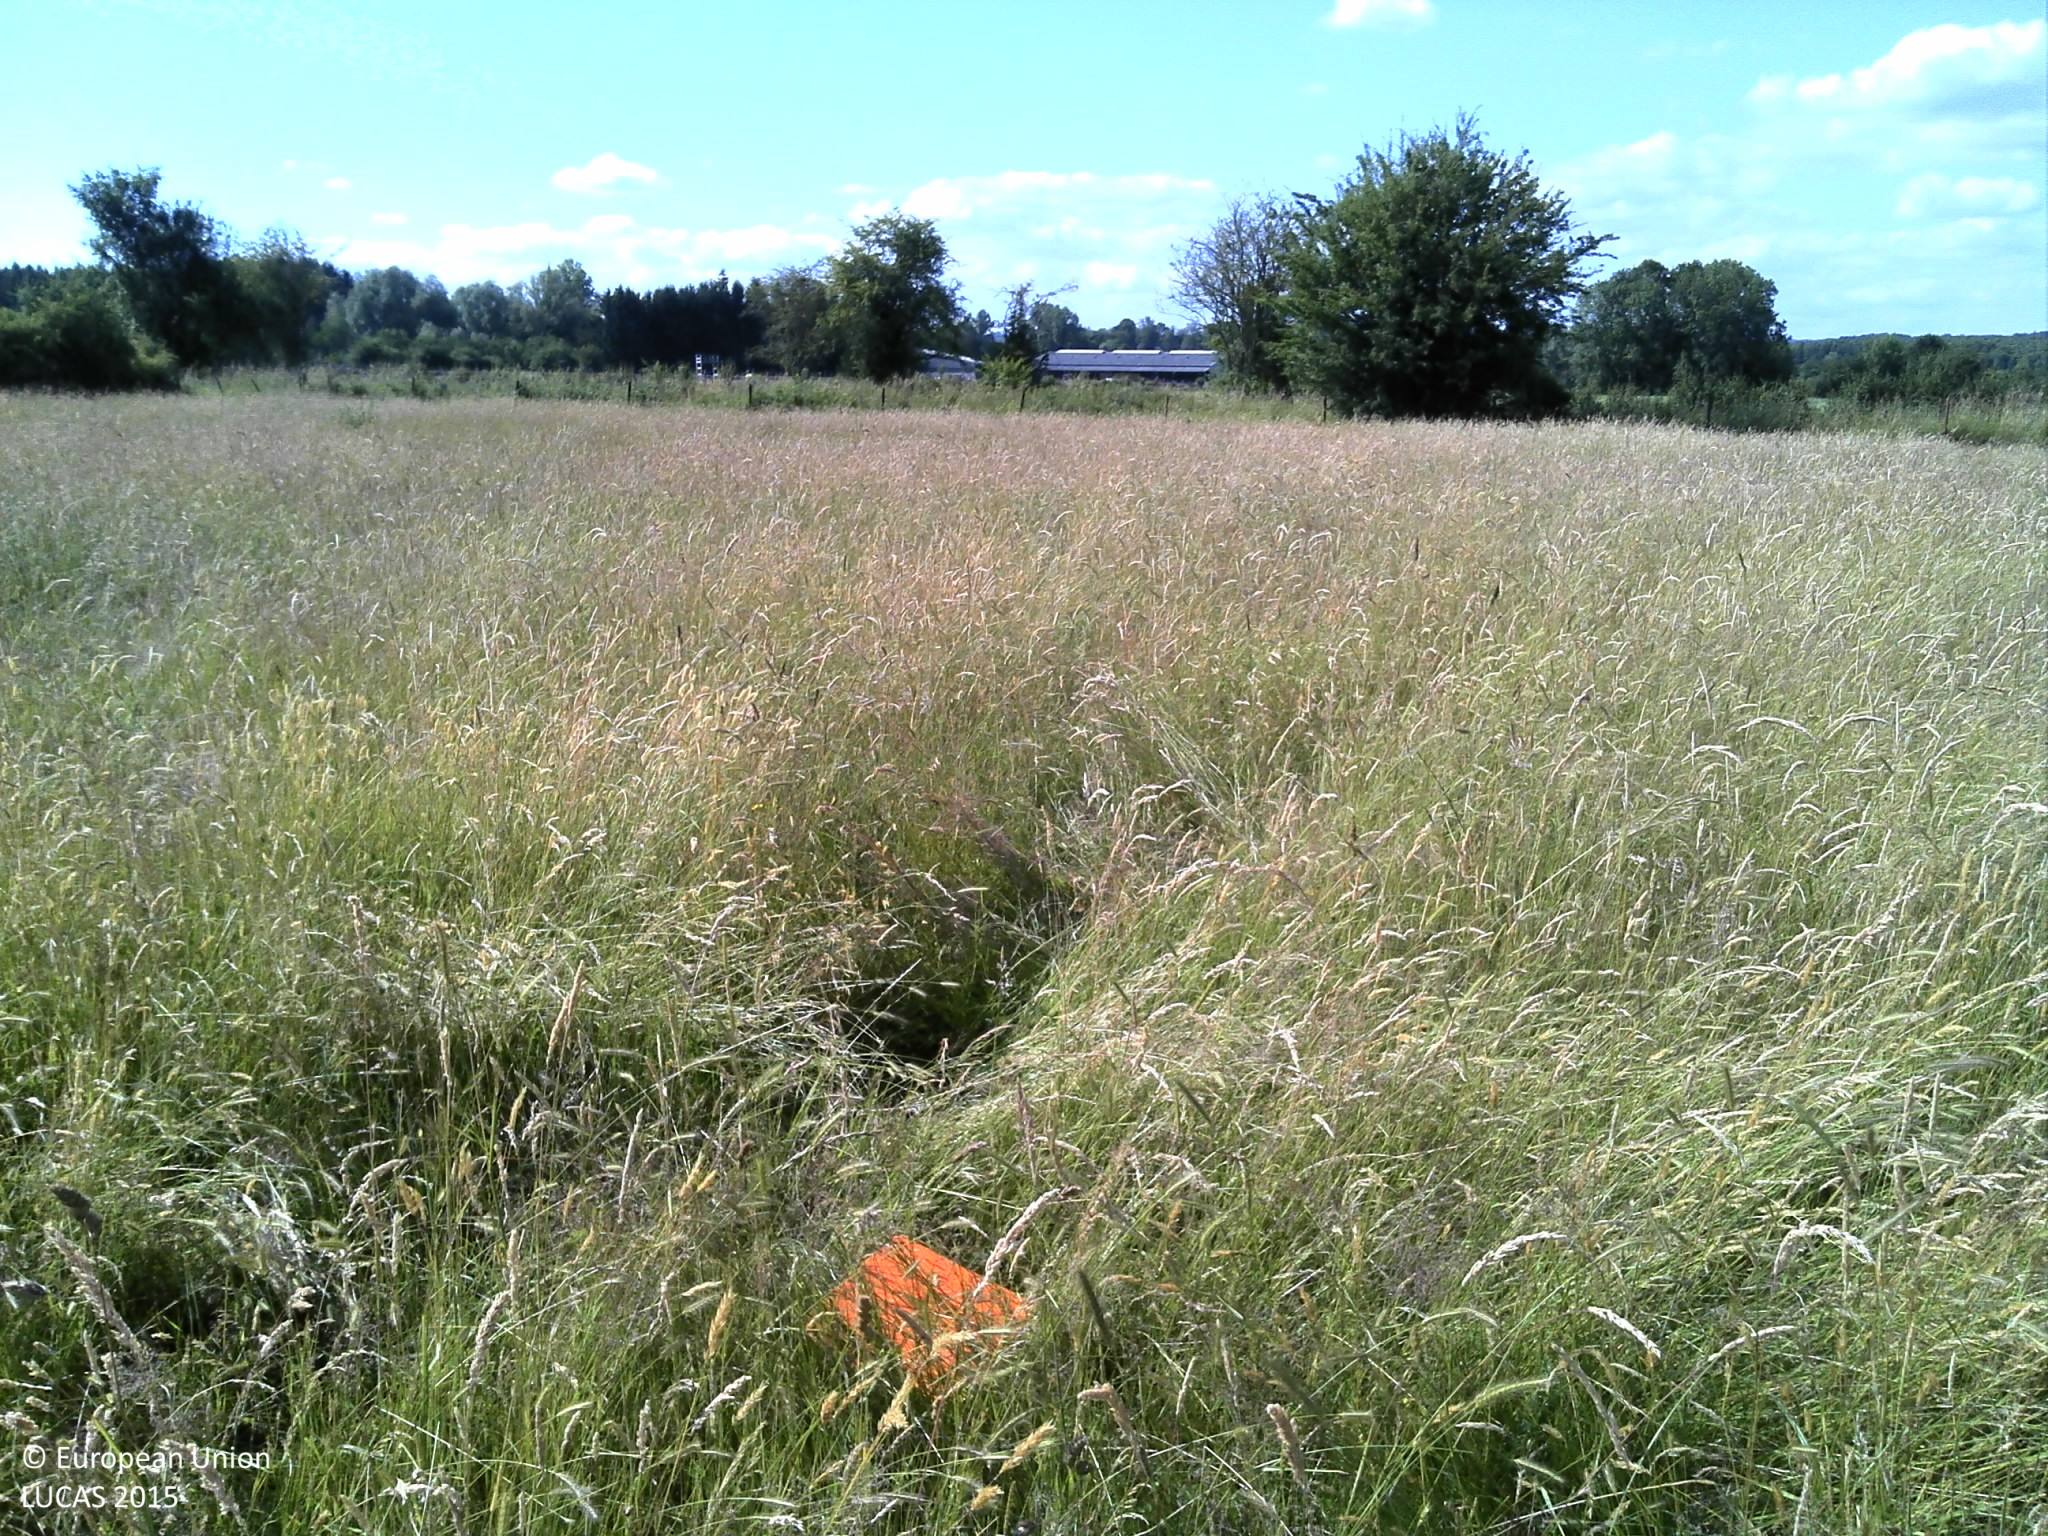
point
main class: Grassland
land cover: Grassland without tree/shrub cover
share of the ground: > 75 %
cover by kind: herbaceous plants 100 %
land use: Agriculture (excluding fallow land and kitchen gardens)
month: June
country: FR
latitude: 49.6625
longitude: 5.0517
